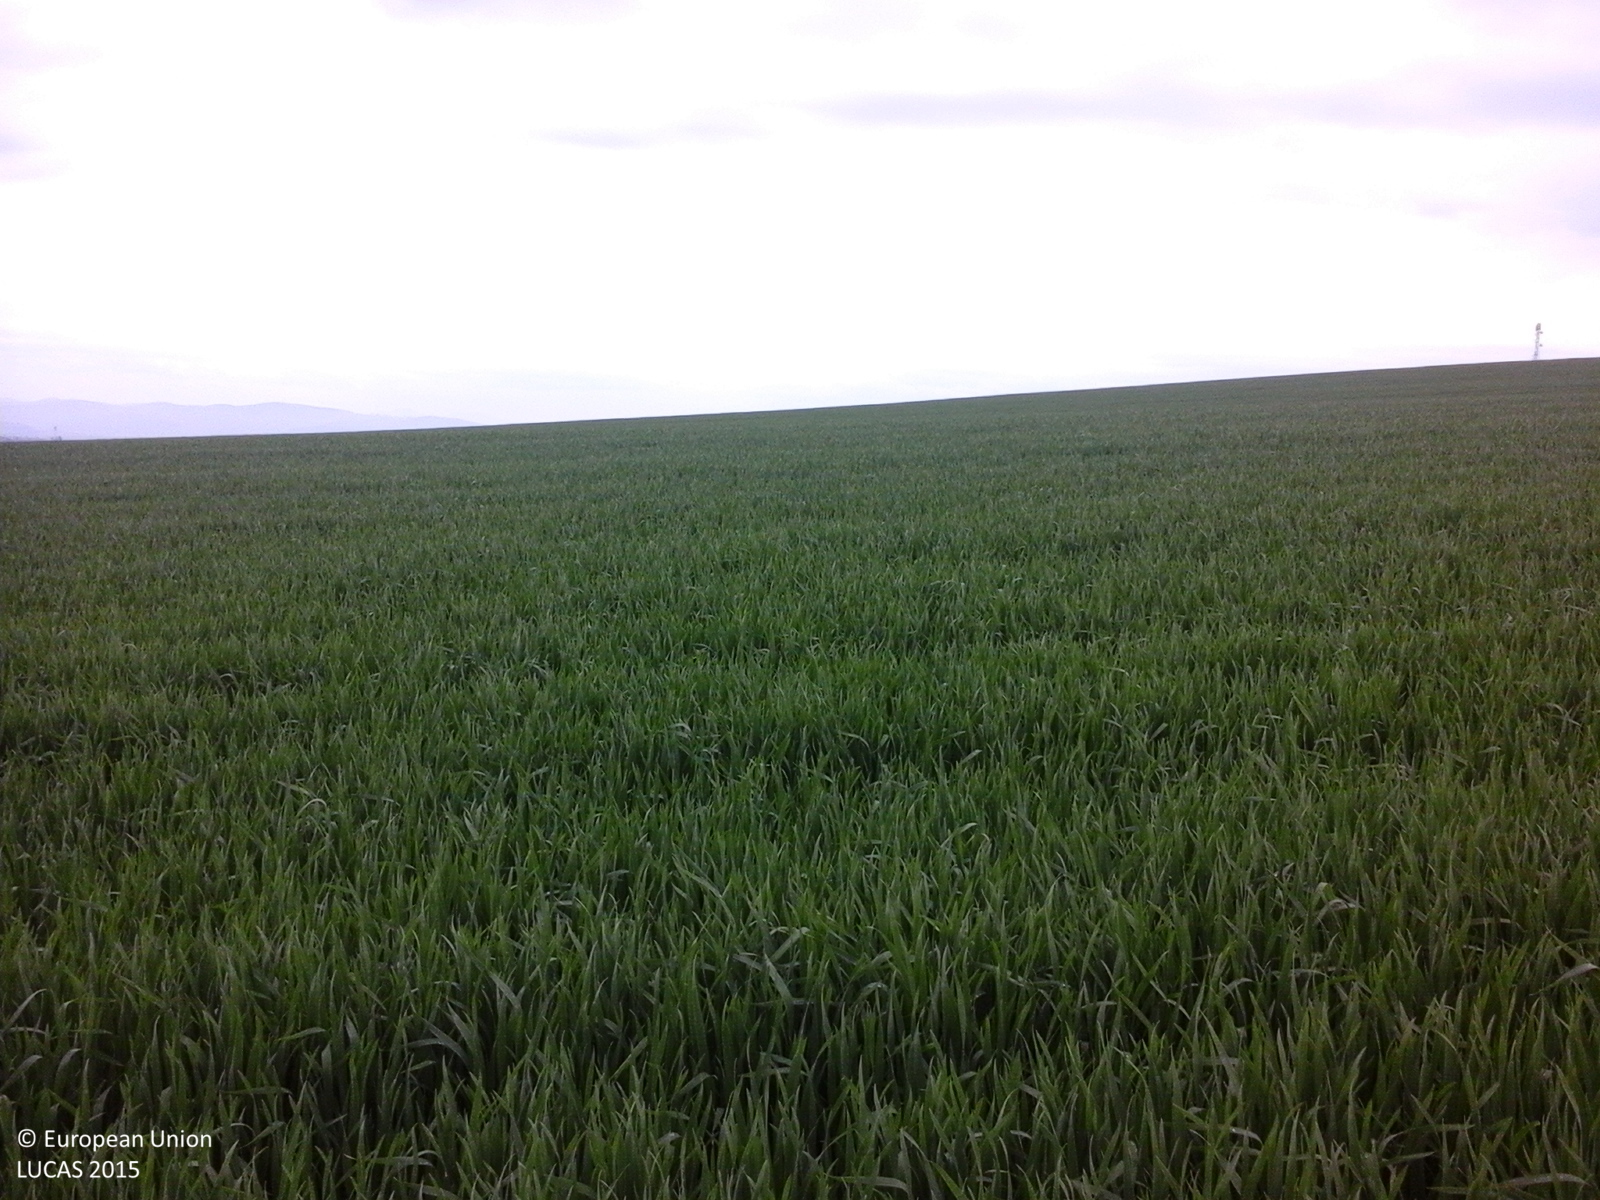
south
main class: Cropland
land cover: Common wheat
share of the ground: > 75 %
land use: Agriculture (excluding fallow land and kitchen gardens)
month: May
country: RO
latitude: 45.9059
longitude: 26.0106
